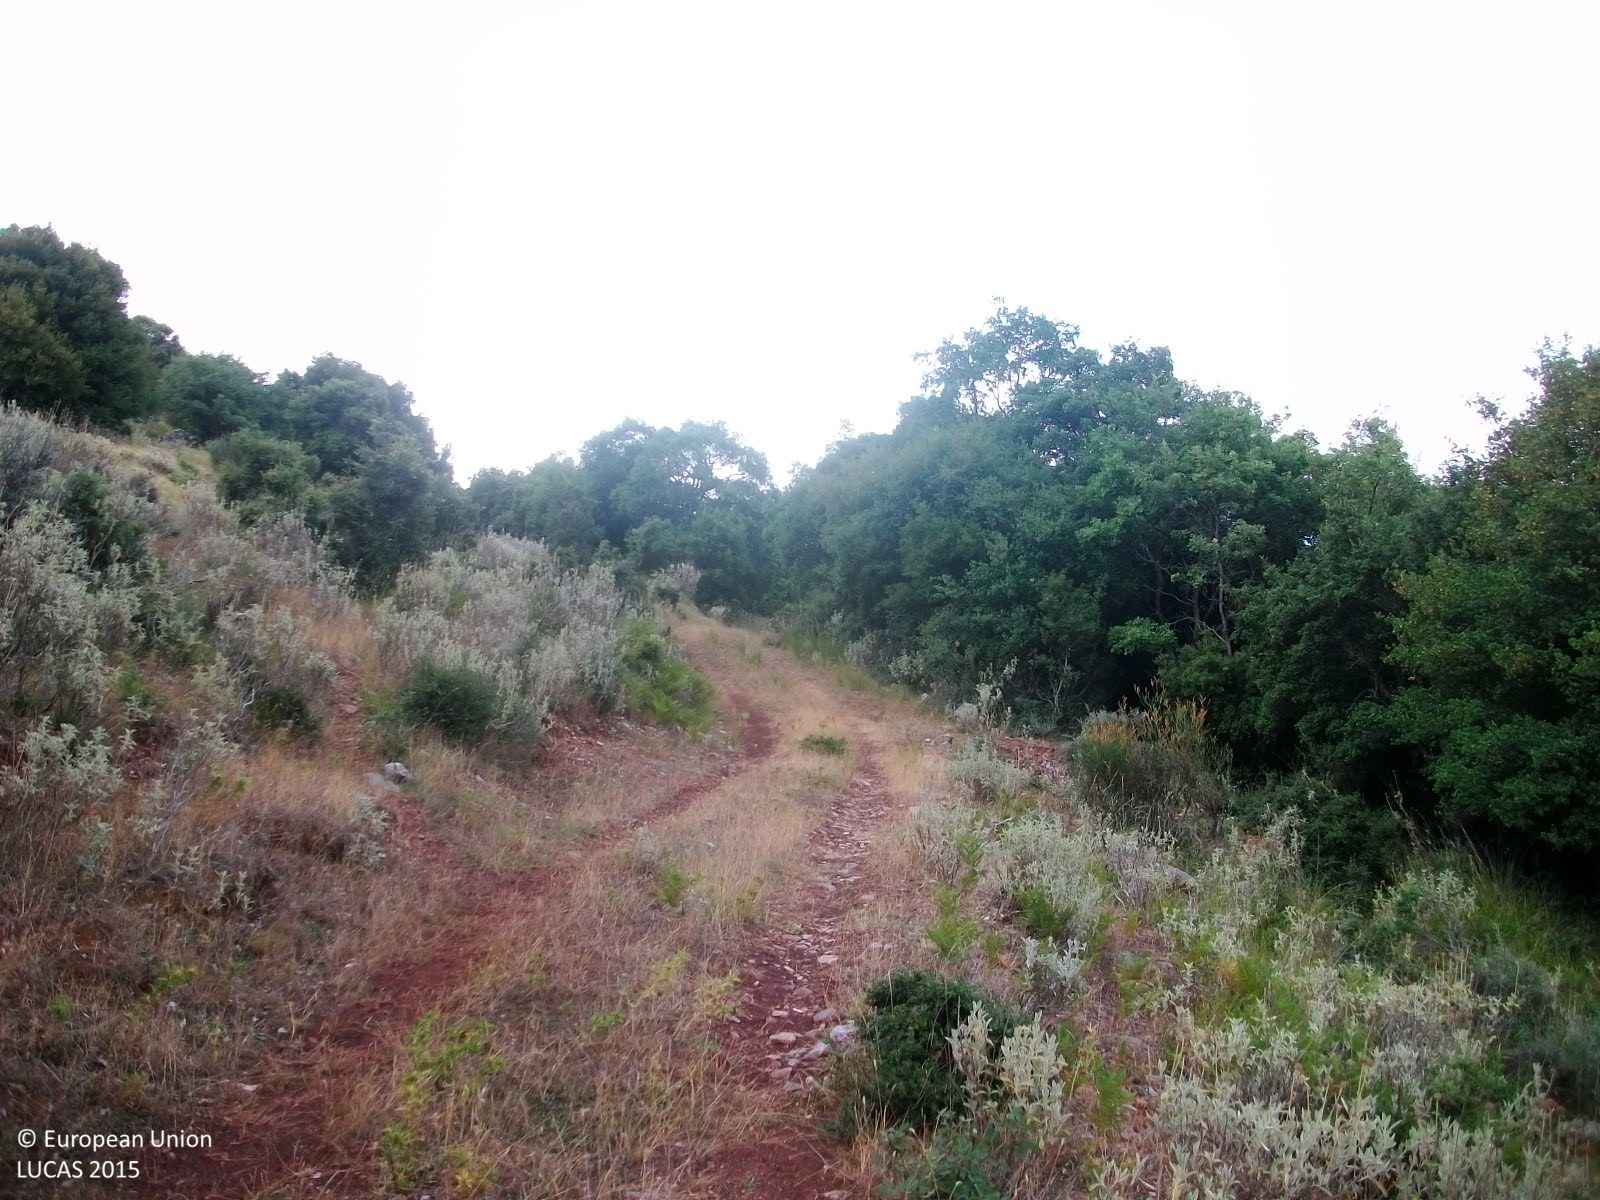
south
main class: Shrubland
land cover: Shrubland with sparse tree cover
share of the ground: > 75 %
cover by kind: shrubs 95 %, broadleaved forest trees 5 %
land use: Semi-natural and natural areas not in use
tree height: > 5 m
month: August
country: GR
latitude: 37.3591
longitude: 21.9361
